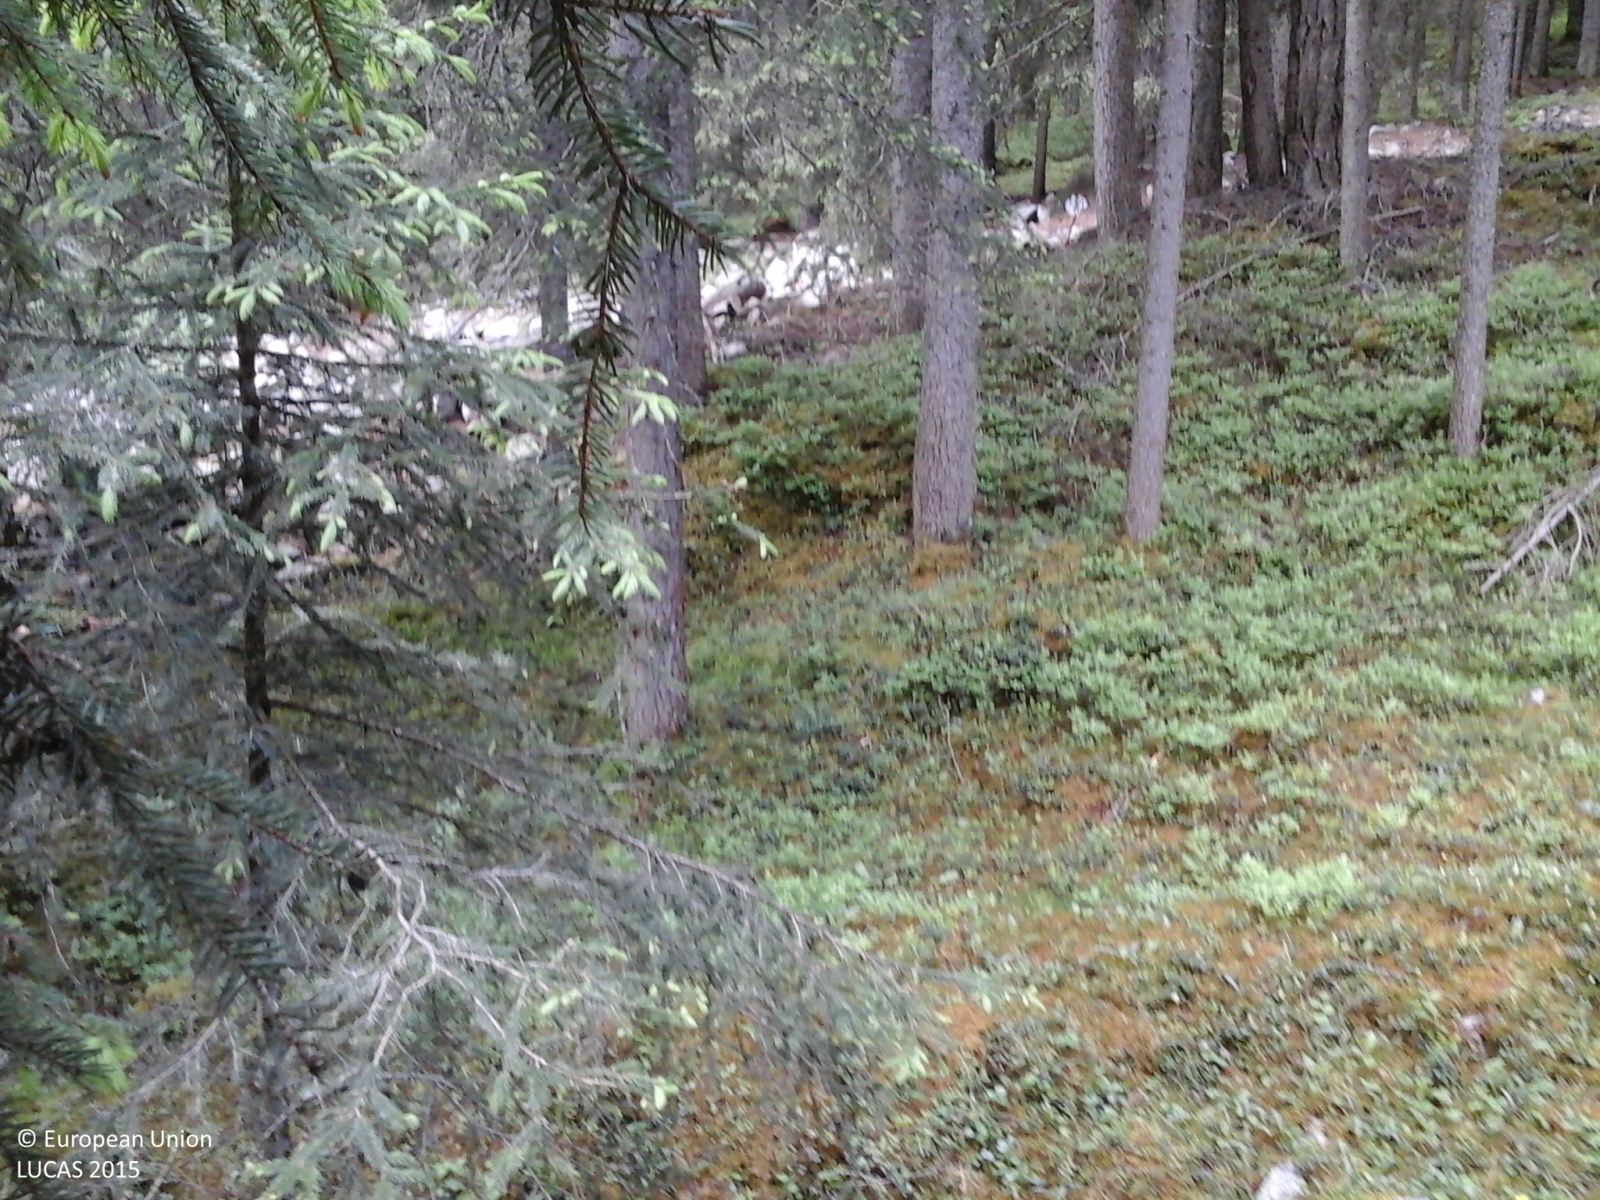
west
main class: Woodland
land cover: Spruce dominated coniferous woodland
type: alpine coniferous forest
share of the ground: > 75 %
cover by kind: coniferous forest trees 100 %
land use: Forestry
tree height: > 5 m
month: June
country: IT
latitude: 46.9699
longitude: 11.5888
